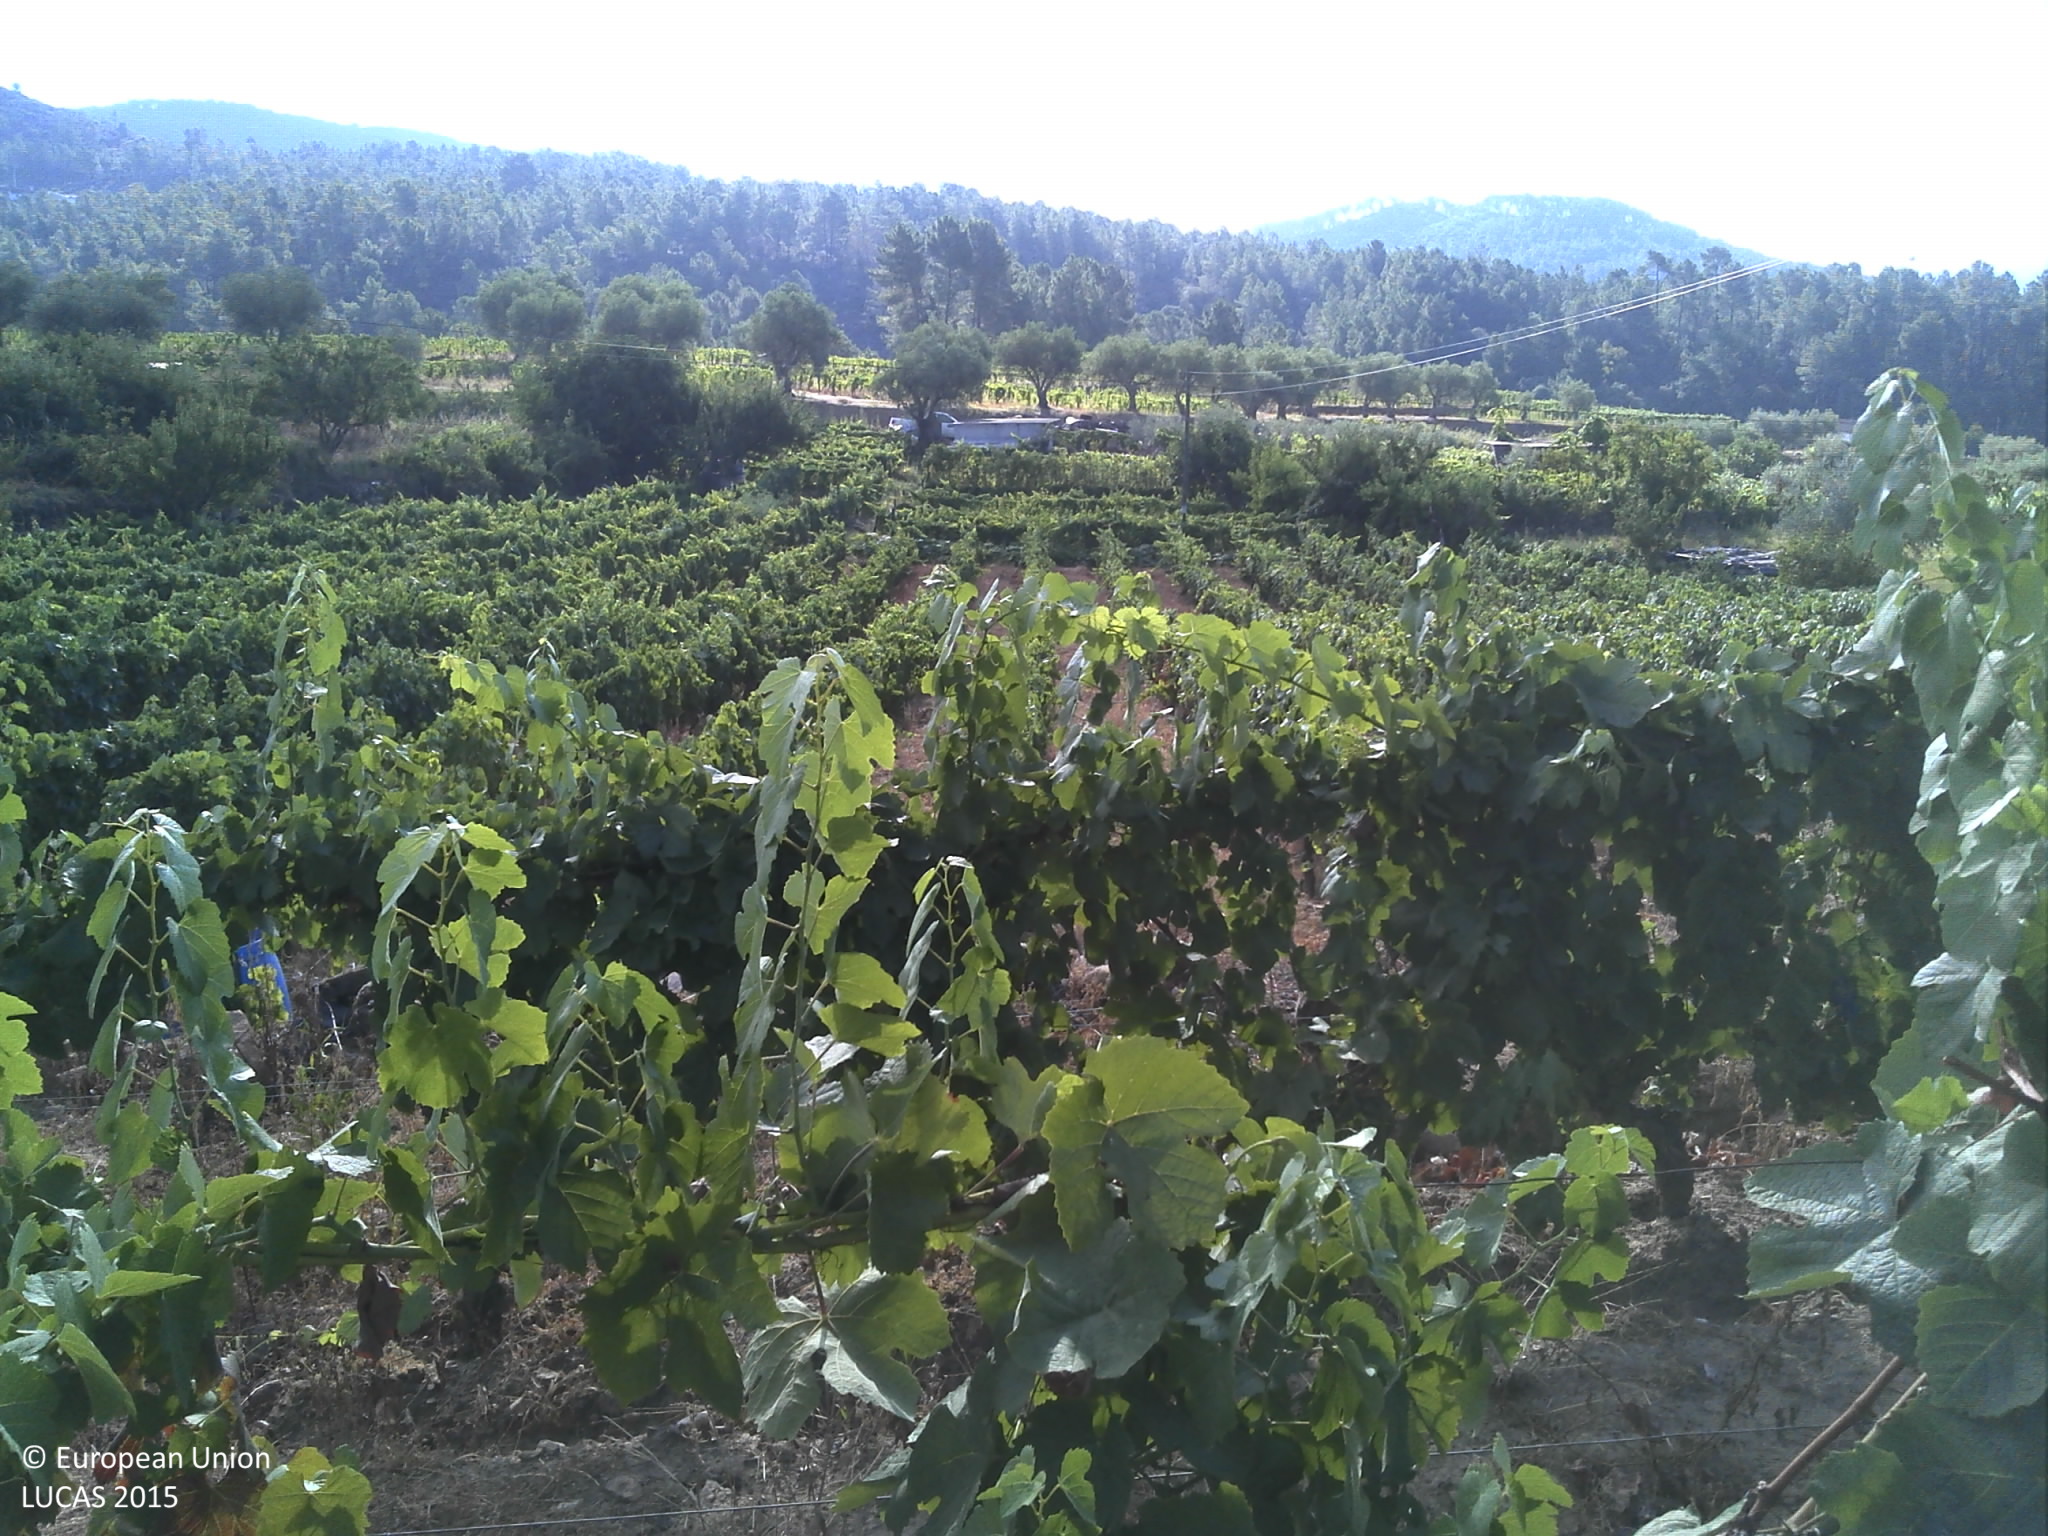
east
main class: Cropland
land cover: Vineyards
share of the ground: < 10 %
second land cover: Grassland without tree/shrub cover
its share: 50 - 75 %
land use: Agriculture (excluding fallow land and kitchen gardens)
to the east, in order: Vineyards; Grassland without tree/shrub cover; Vineyards; Dry stone walls; Vineyards; Electric lines; Vineyards; Potatoes; Vineyards; Artificial constructions in urban areas; Single bushes/trees; Dry stone walls; Tracks; Olive groves; Tracks; Vineyards; Dry stone walls; Vineyards; Pine dominated coniferous woodland
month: July
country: PT
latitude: 41.2563
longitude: -7.4393
